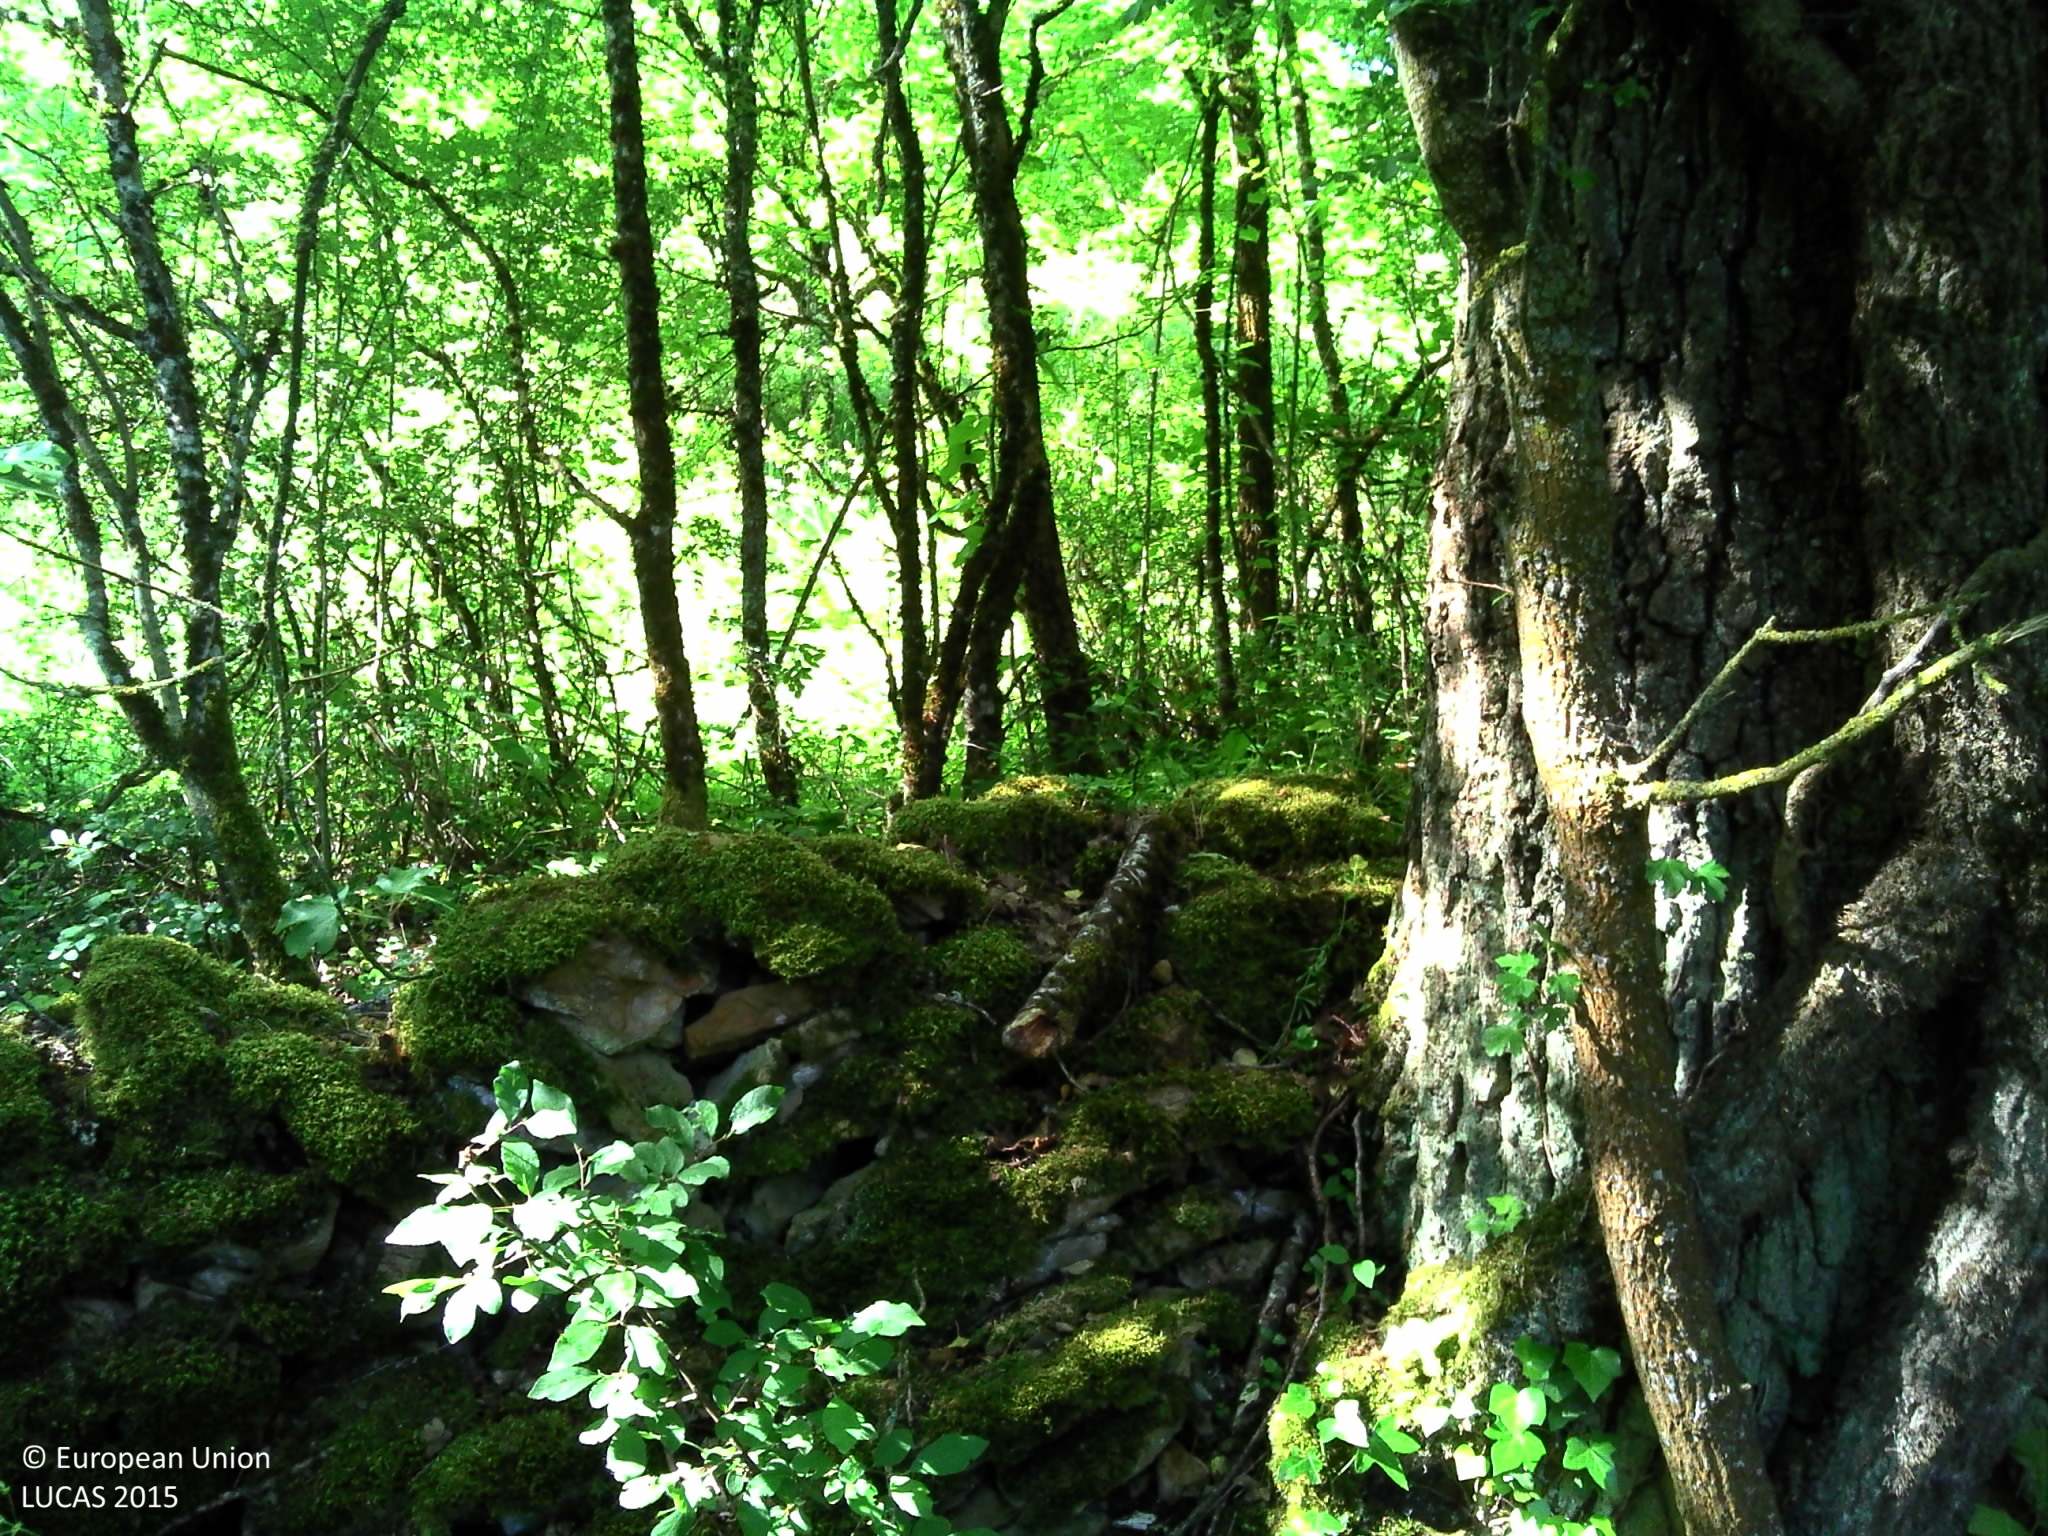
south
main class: Woodland
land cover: Broadleaved woodland
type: acidophilous oak and oak-birch forest
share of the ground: > 75 %
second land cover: Grassland without tree/shrub cover
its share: 50 - 75 %
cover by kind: broadleaved forest trees 60 %, herbaceous plants 35 %, lichens and mosses 5 %
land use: Forestry
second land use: Agriculture (excluding fallow land and kitchen gardens)
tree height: > 5 m
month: May
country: FR
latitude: 44.3910
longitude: 2.5589
